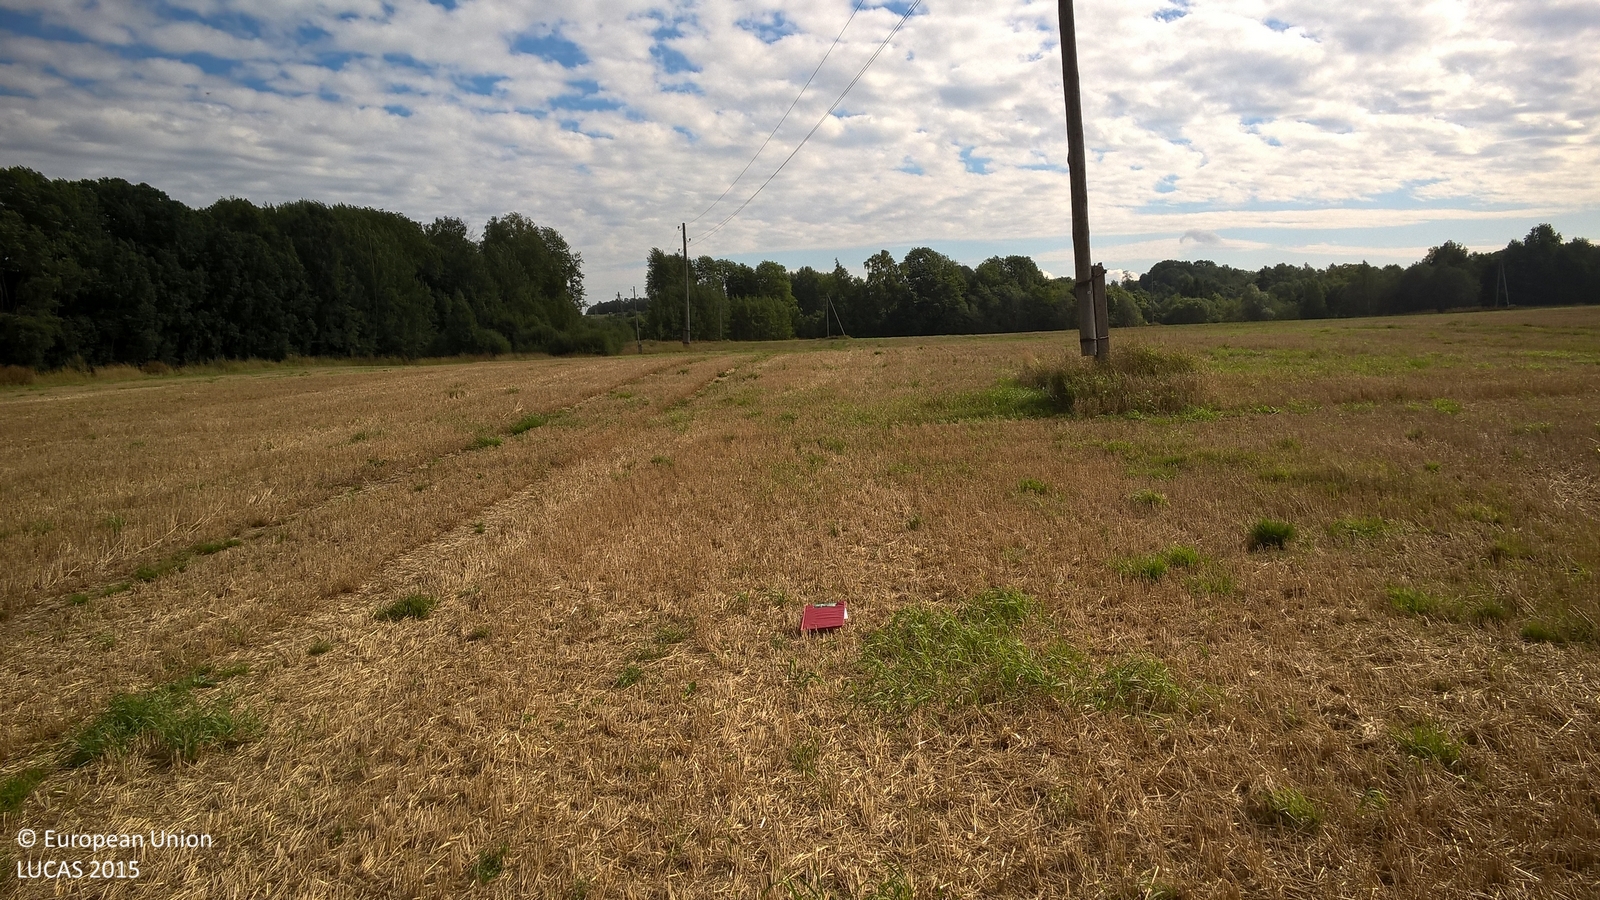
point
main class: Cropland
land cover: Barley
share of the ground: < 10 %
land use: Agriculture (excluding fallow land and kitchen gardens)
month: September
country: LV
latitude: 57.3326
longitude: 25.4809
